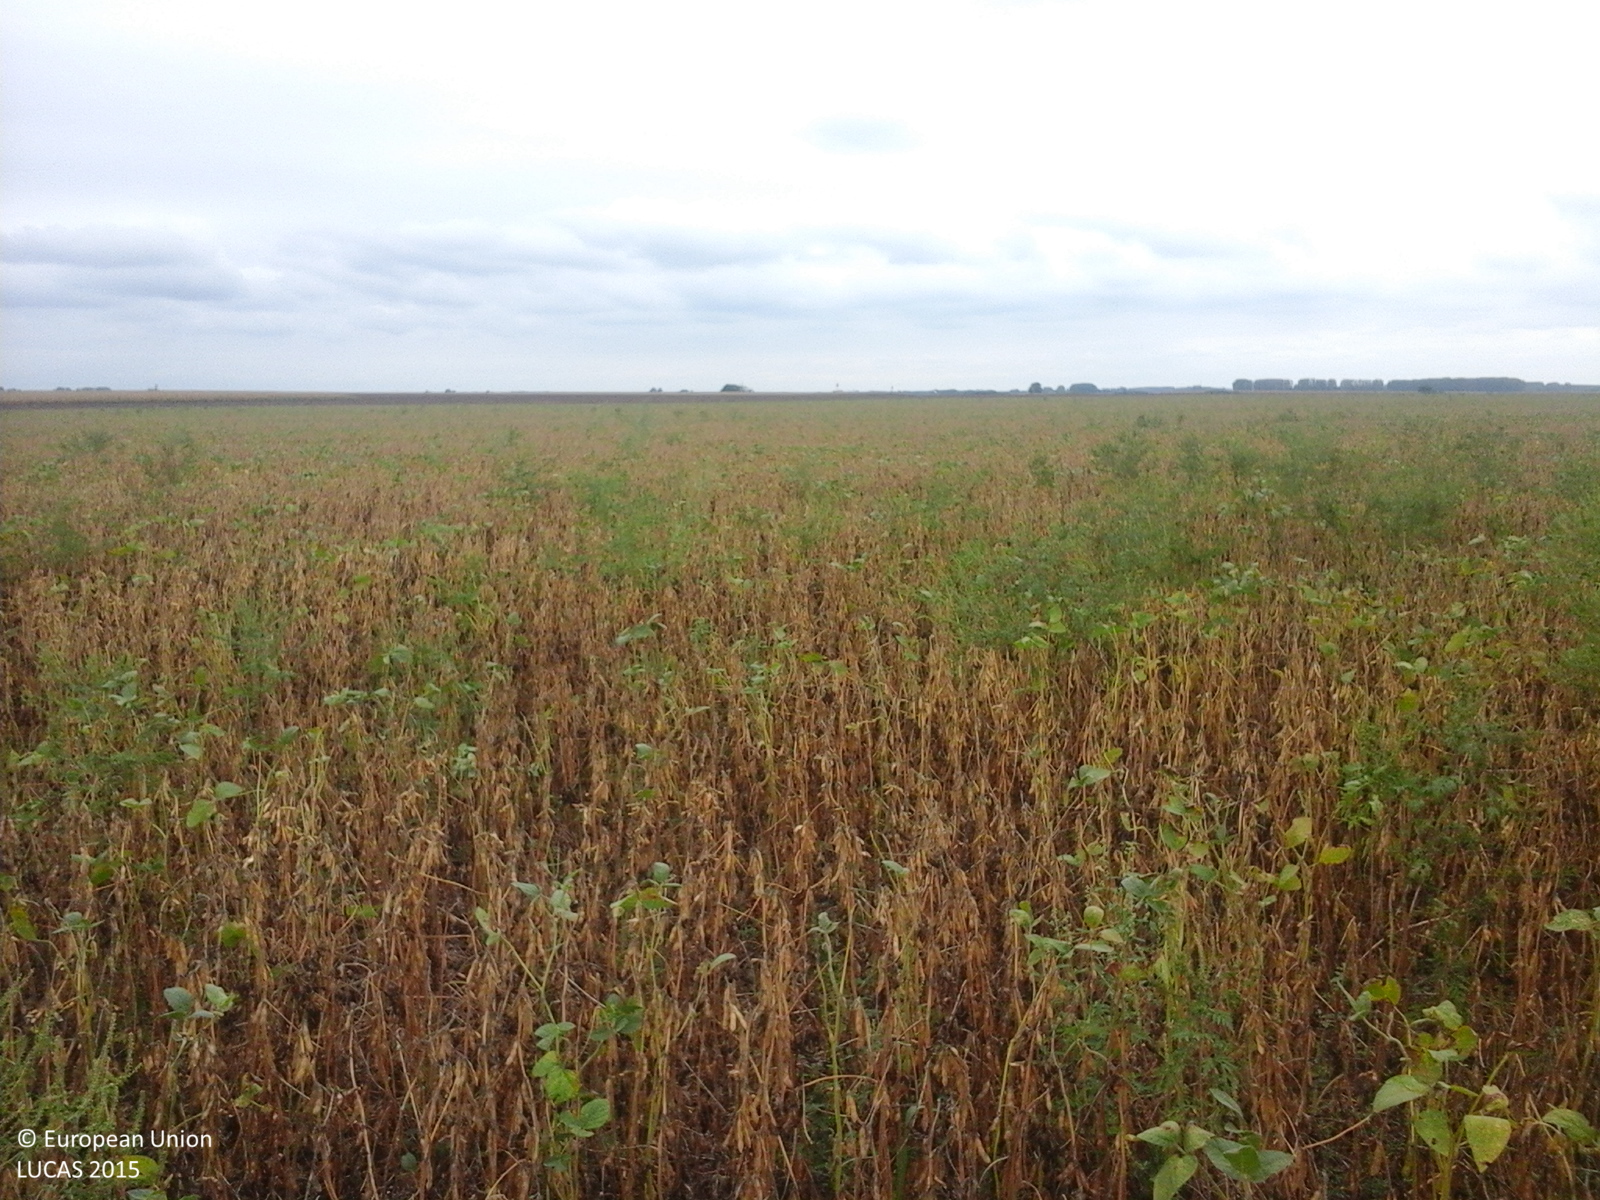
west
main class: Cropland
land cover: Soya
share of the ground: > 75 %
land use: Agriculture (excluding fallow land and kitchen gardens)
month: September
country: RO
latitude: 47.3704
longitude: 21.9535
